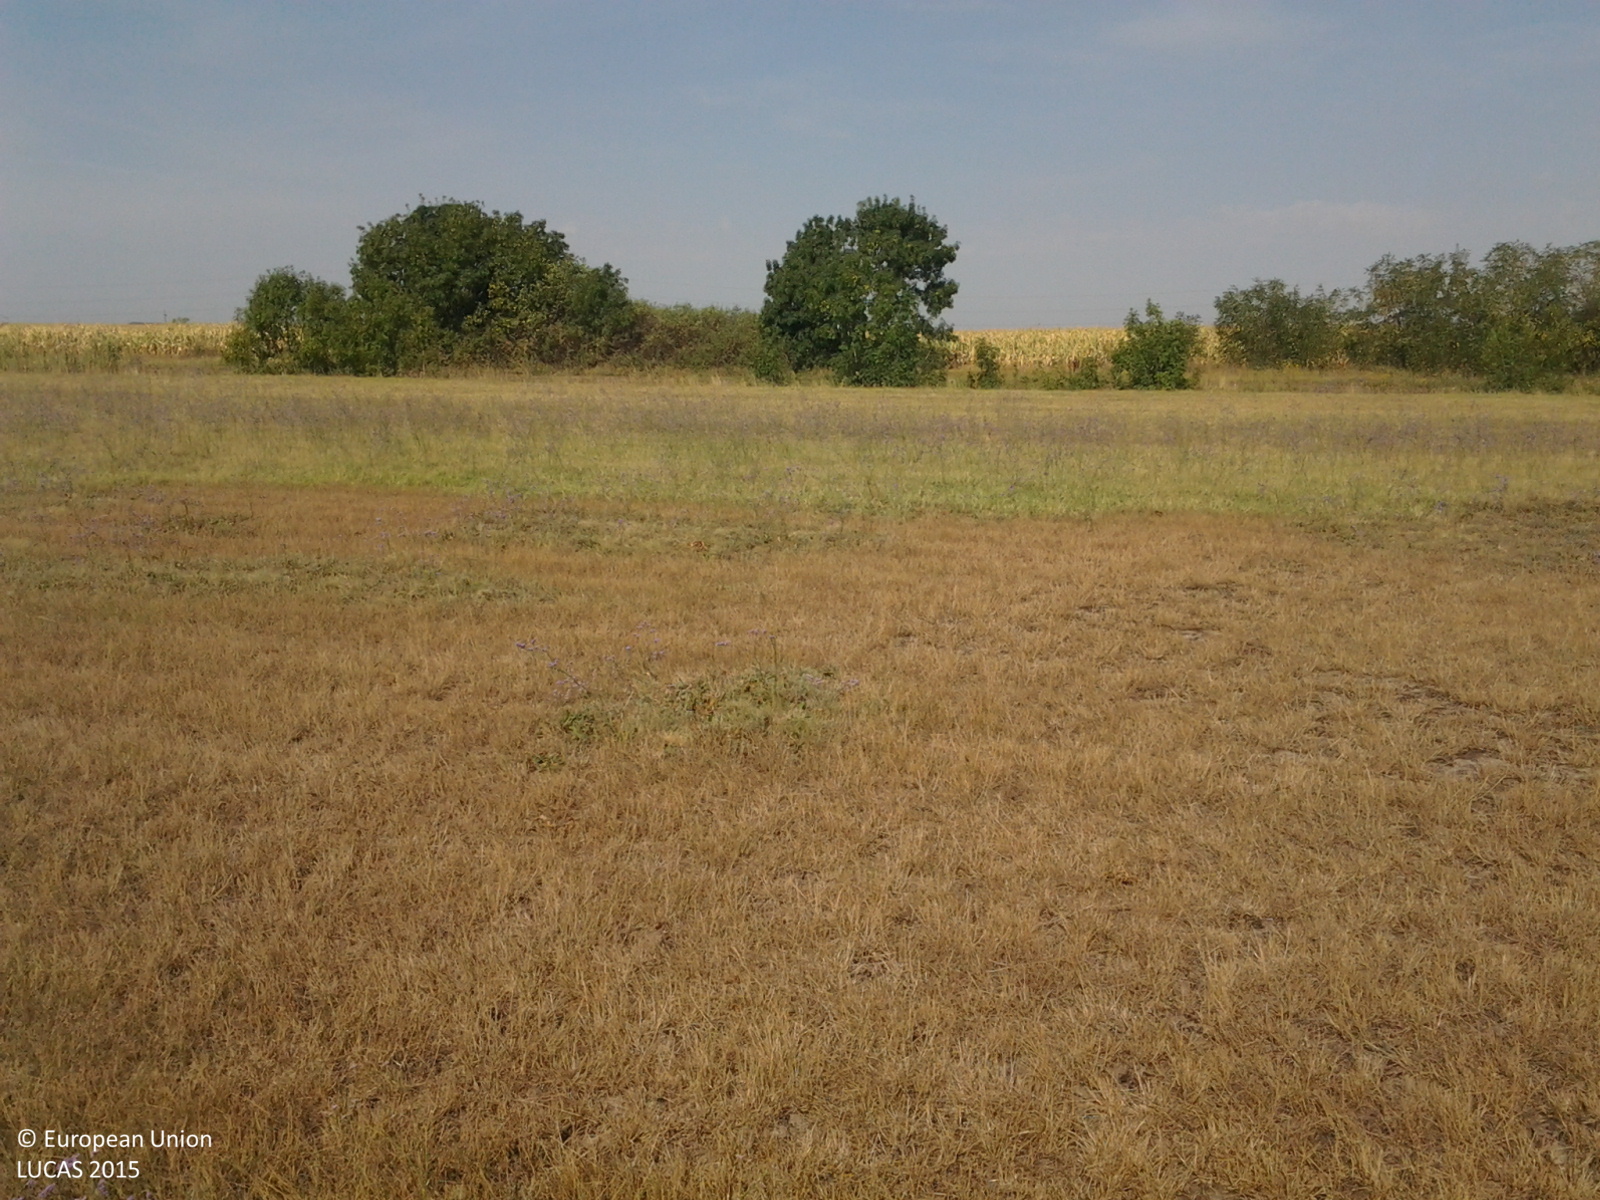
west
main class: Grassland
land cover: Grassland without tree/shrub cover
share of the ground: > 75 %
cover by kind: herbaceous plants 100 %
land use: Agriculture (excluding fallow land and kitchen gardens)
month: August
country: HU
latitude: 47.4465
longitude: 19.7443
